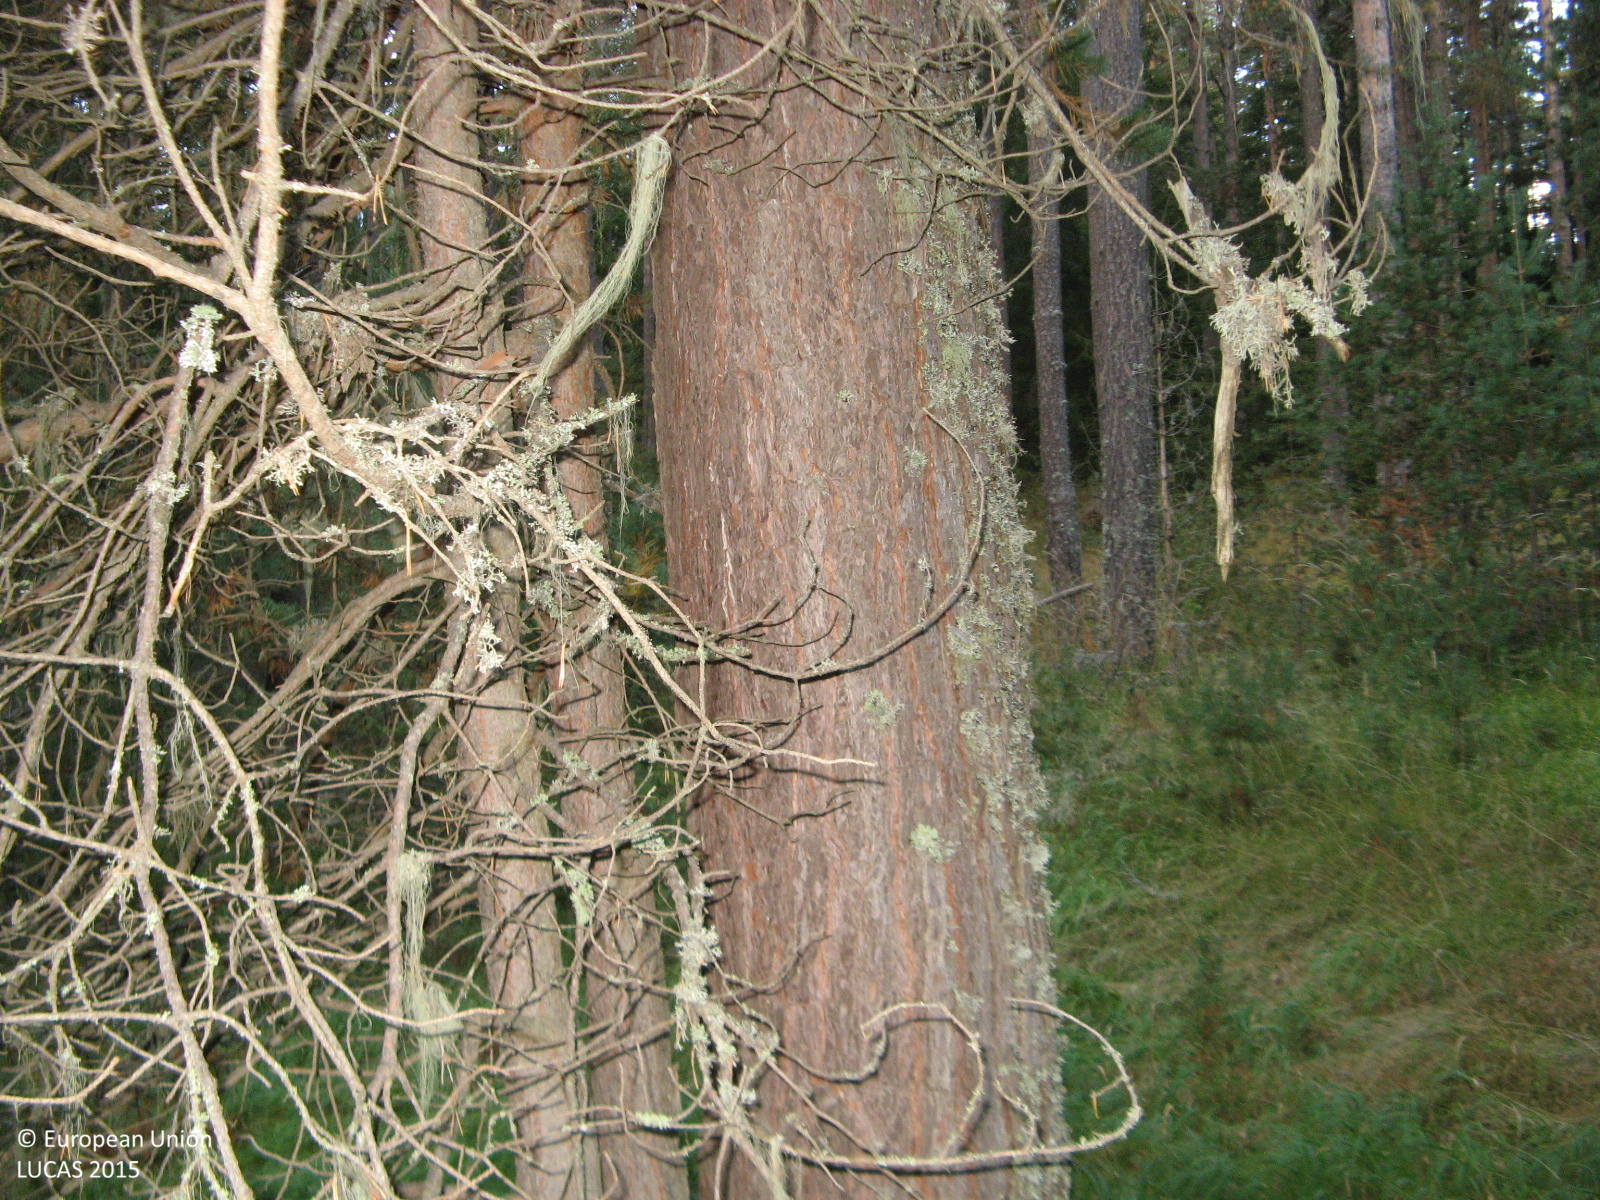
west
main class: Woodland
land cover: Pine dominated coniferous woodland
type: alpine coniferous forest
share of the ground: > 75 %
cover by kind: coniferous forest trees 90 %, herbaceous plants 10 %
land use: Forestry
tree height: > 5 m
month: September
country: BG
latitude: 41.6911
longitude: 24.1535
